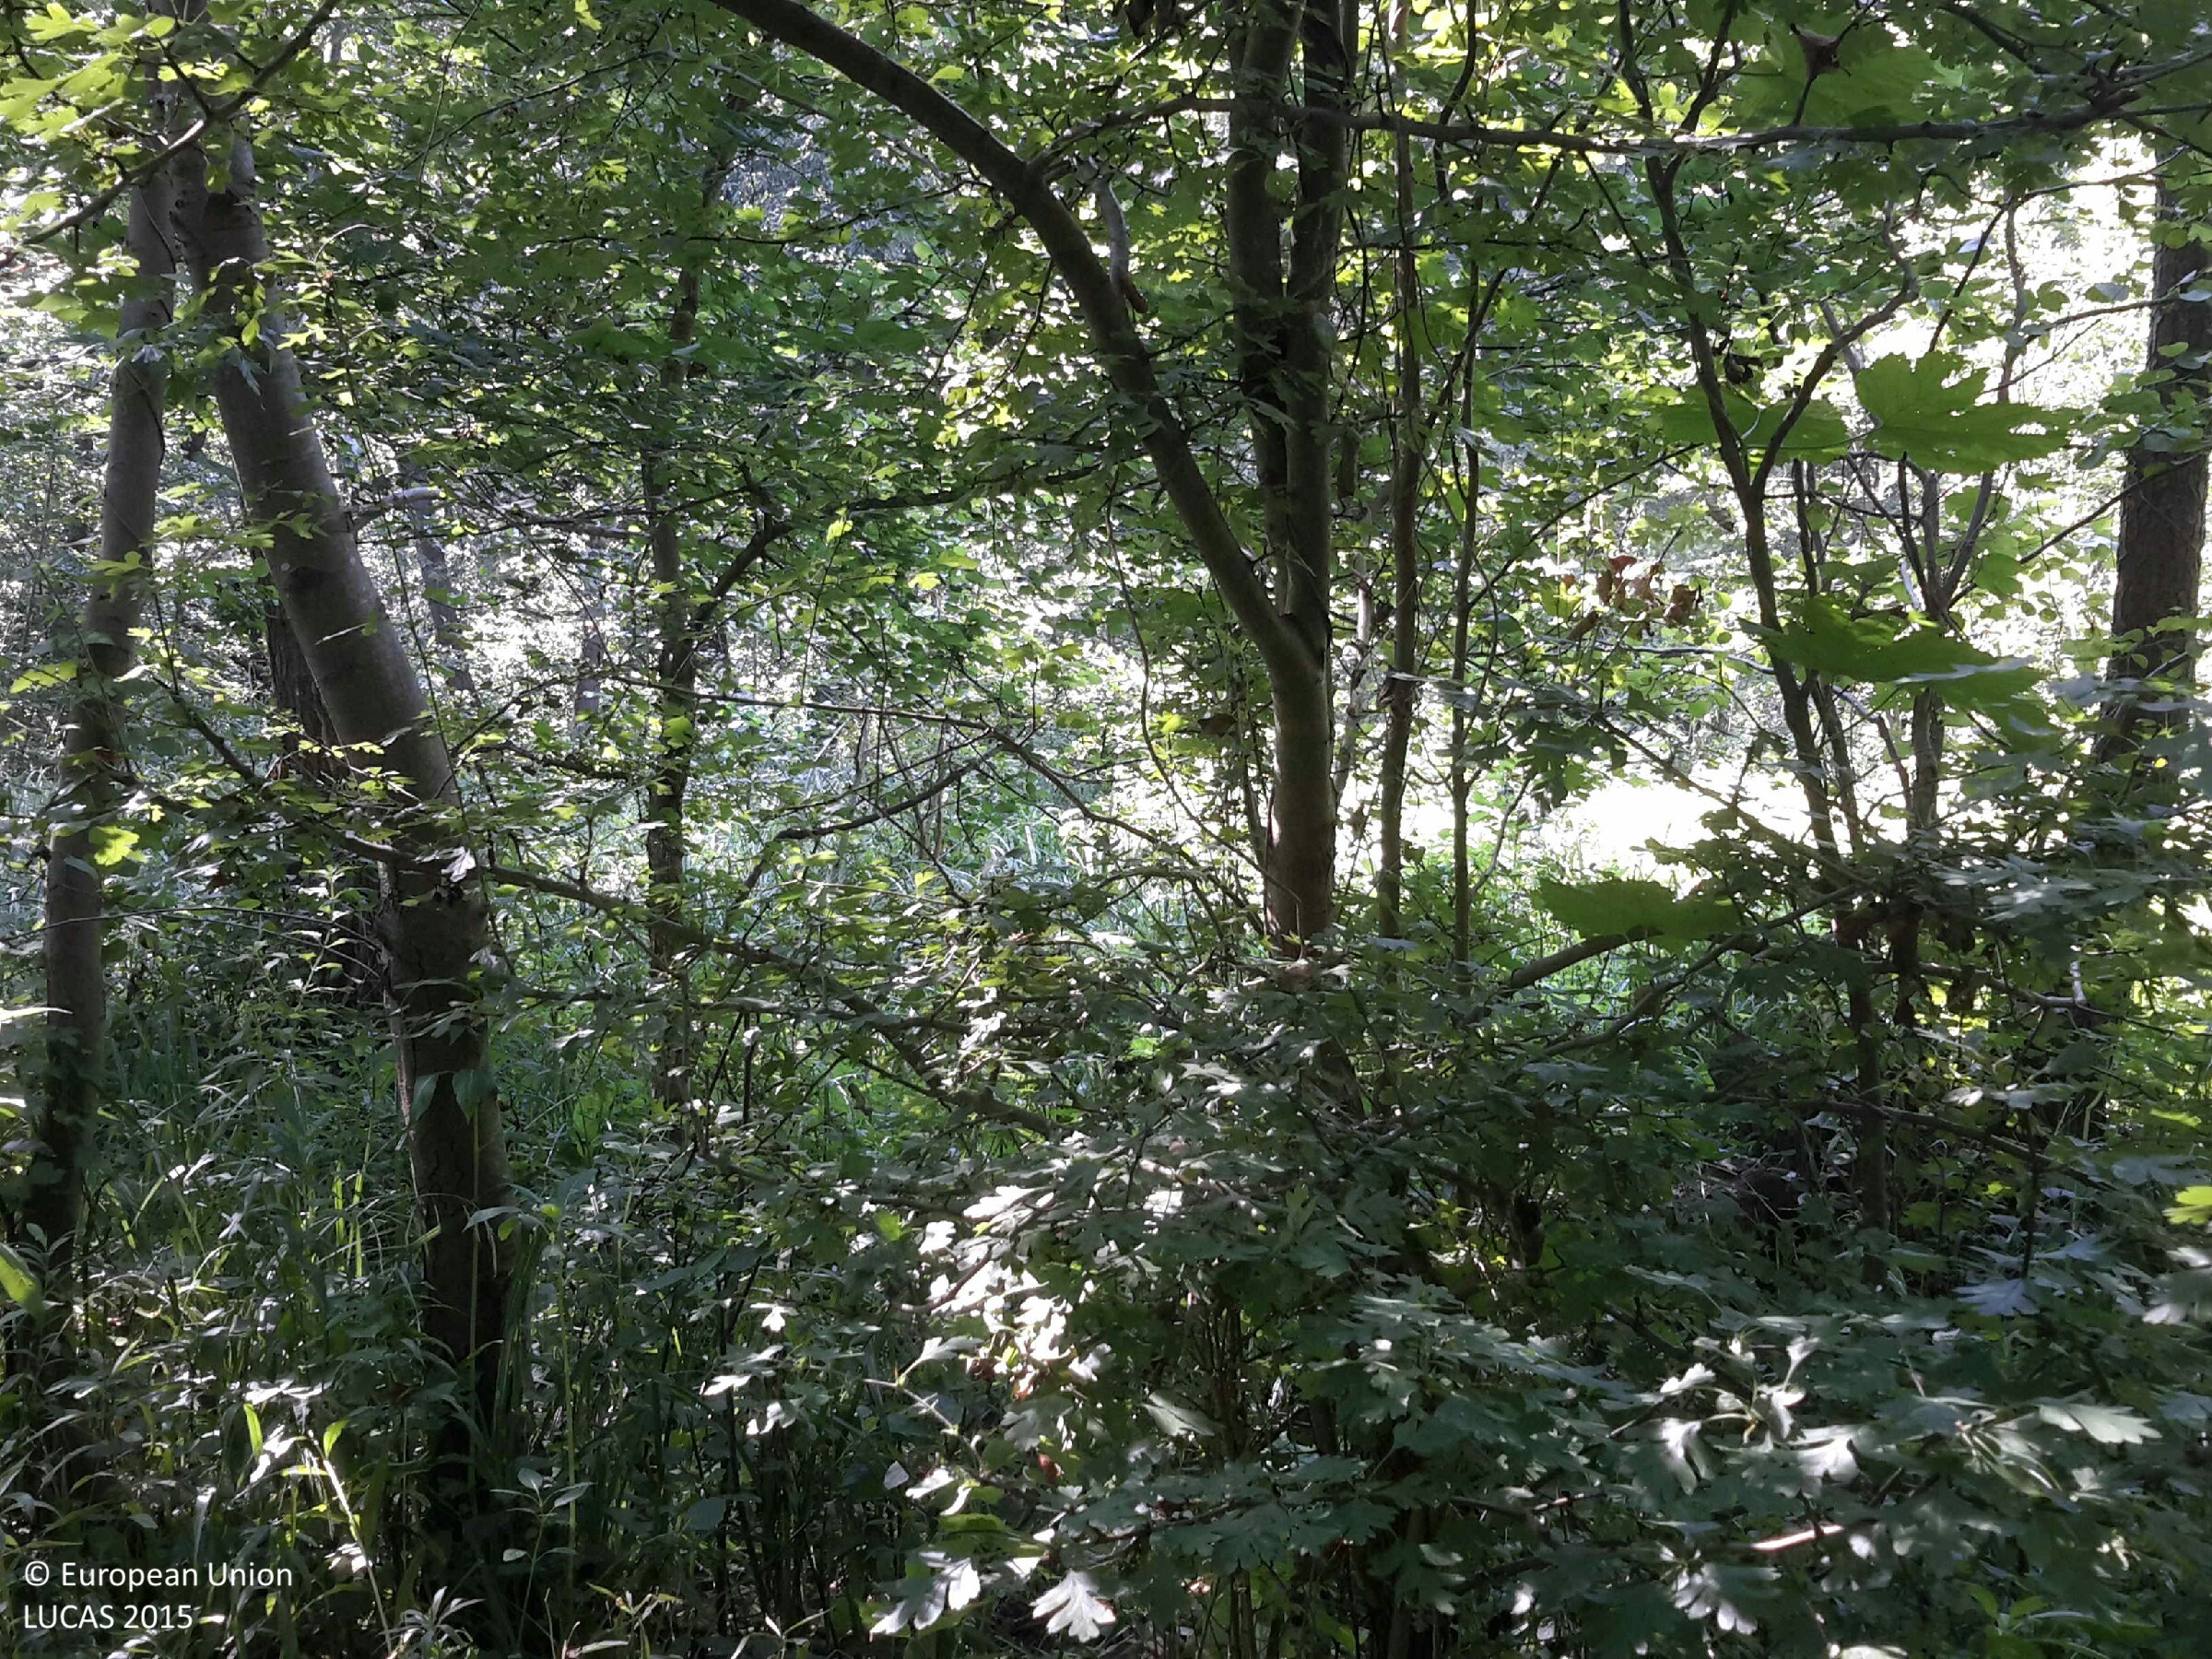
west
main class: Woodland
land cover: Broadleaved woodland
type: mesophytic deciduous forest
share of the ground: > 75 %
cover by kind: broadleaved forest trees 90 %, herbaceous plants 10 %
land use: Forestry
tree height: > 5 m
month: August
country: HU
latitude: 47.8017
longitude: 17.2845
